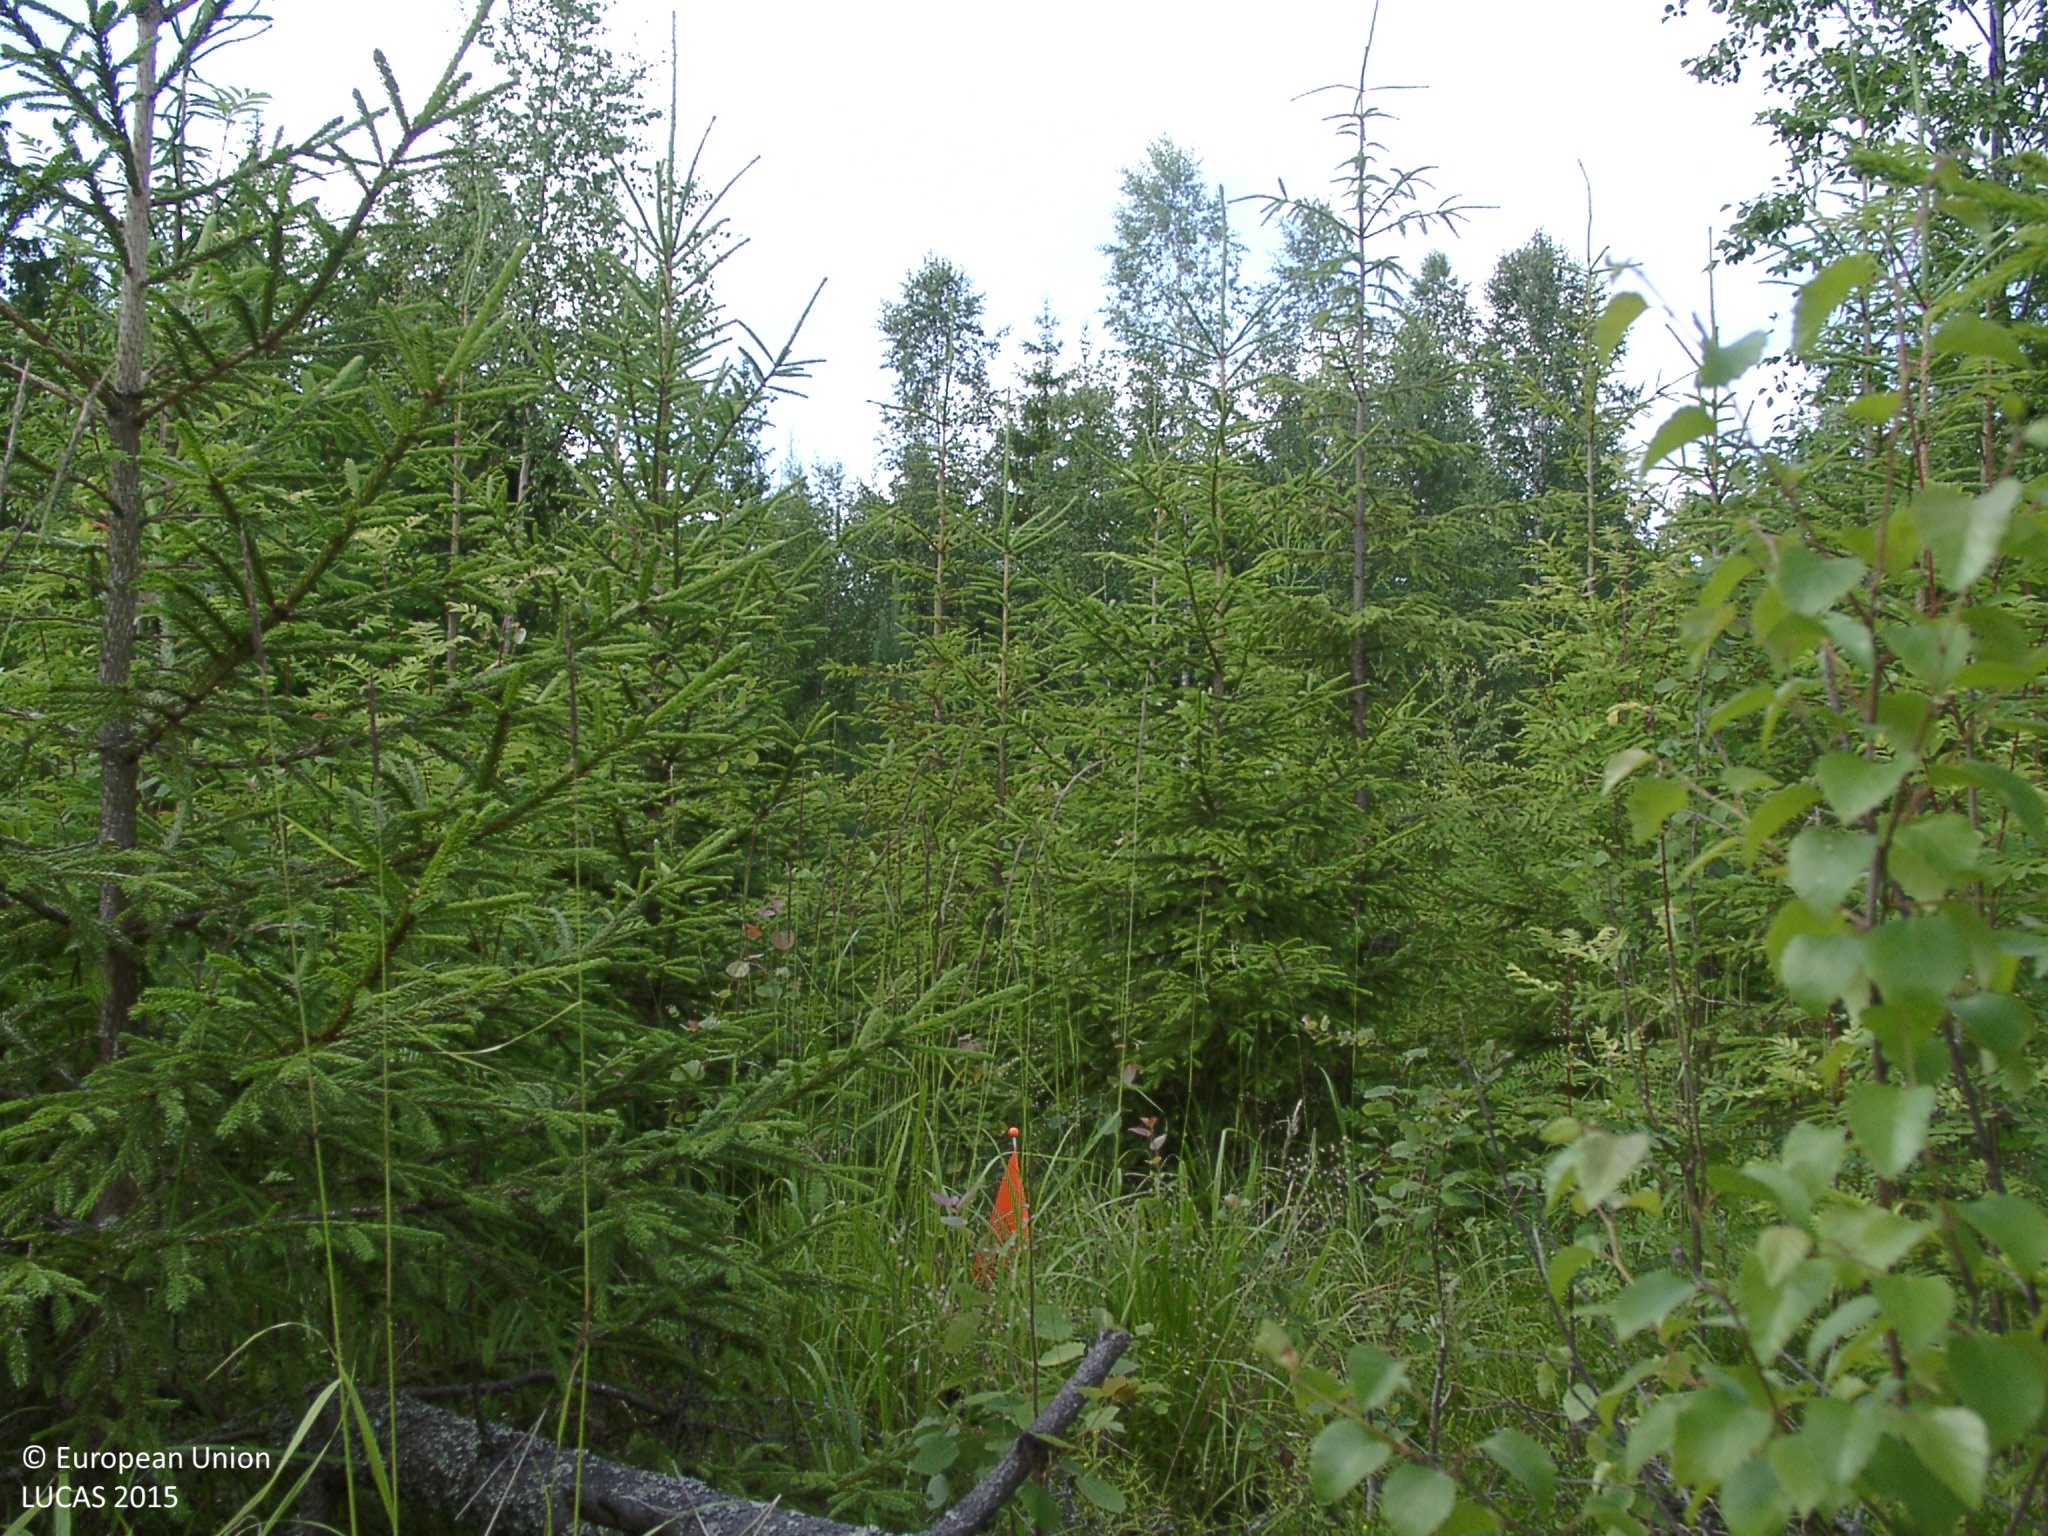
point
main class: Woodland
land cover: Spruce dominated mixed woodland
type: boreal forest
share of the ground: 50 - 75 %
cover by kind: coniferous forest trees 45 %, broadleaved forest trees 20 %, shrubs 20 %, herbaceous plants 15 %
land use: Forestry
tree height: < 5 m
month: July
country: FI
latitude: 61.5816
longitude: 24.9697
